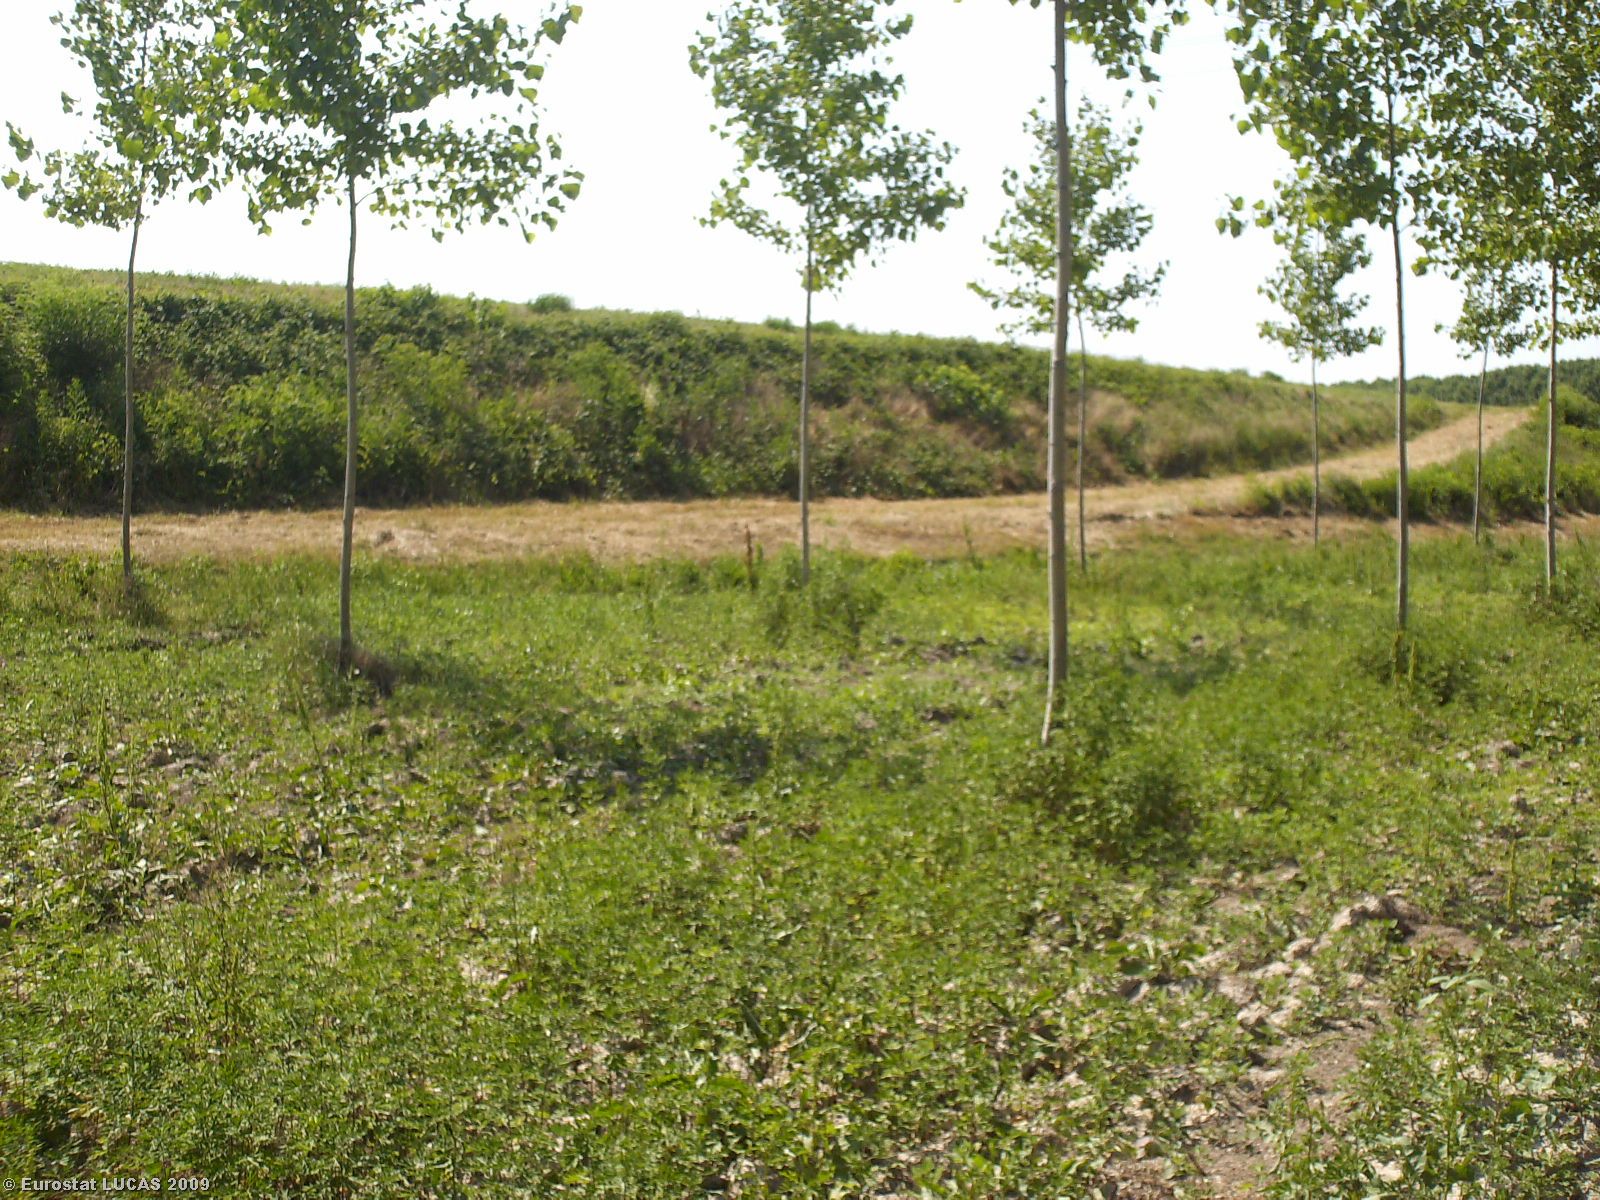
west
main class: Woodland
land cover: Broadleaved woodland
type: non-riverine alder, birch or aspen forest
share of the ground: 25 - 50 %
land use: Forestry
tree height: > 5 m
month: June
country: IT
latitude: 45.1063
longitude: 10.5708
